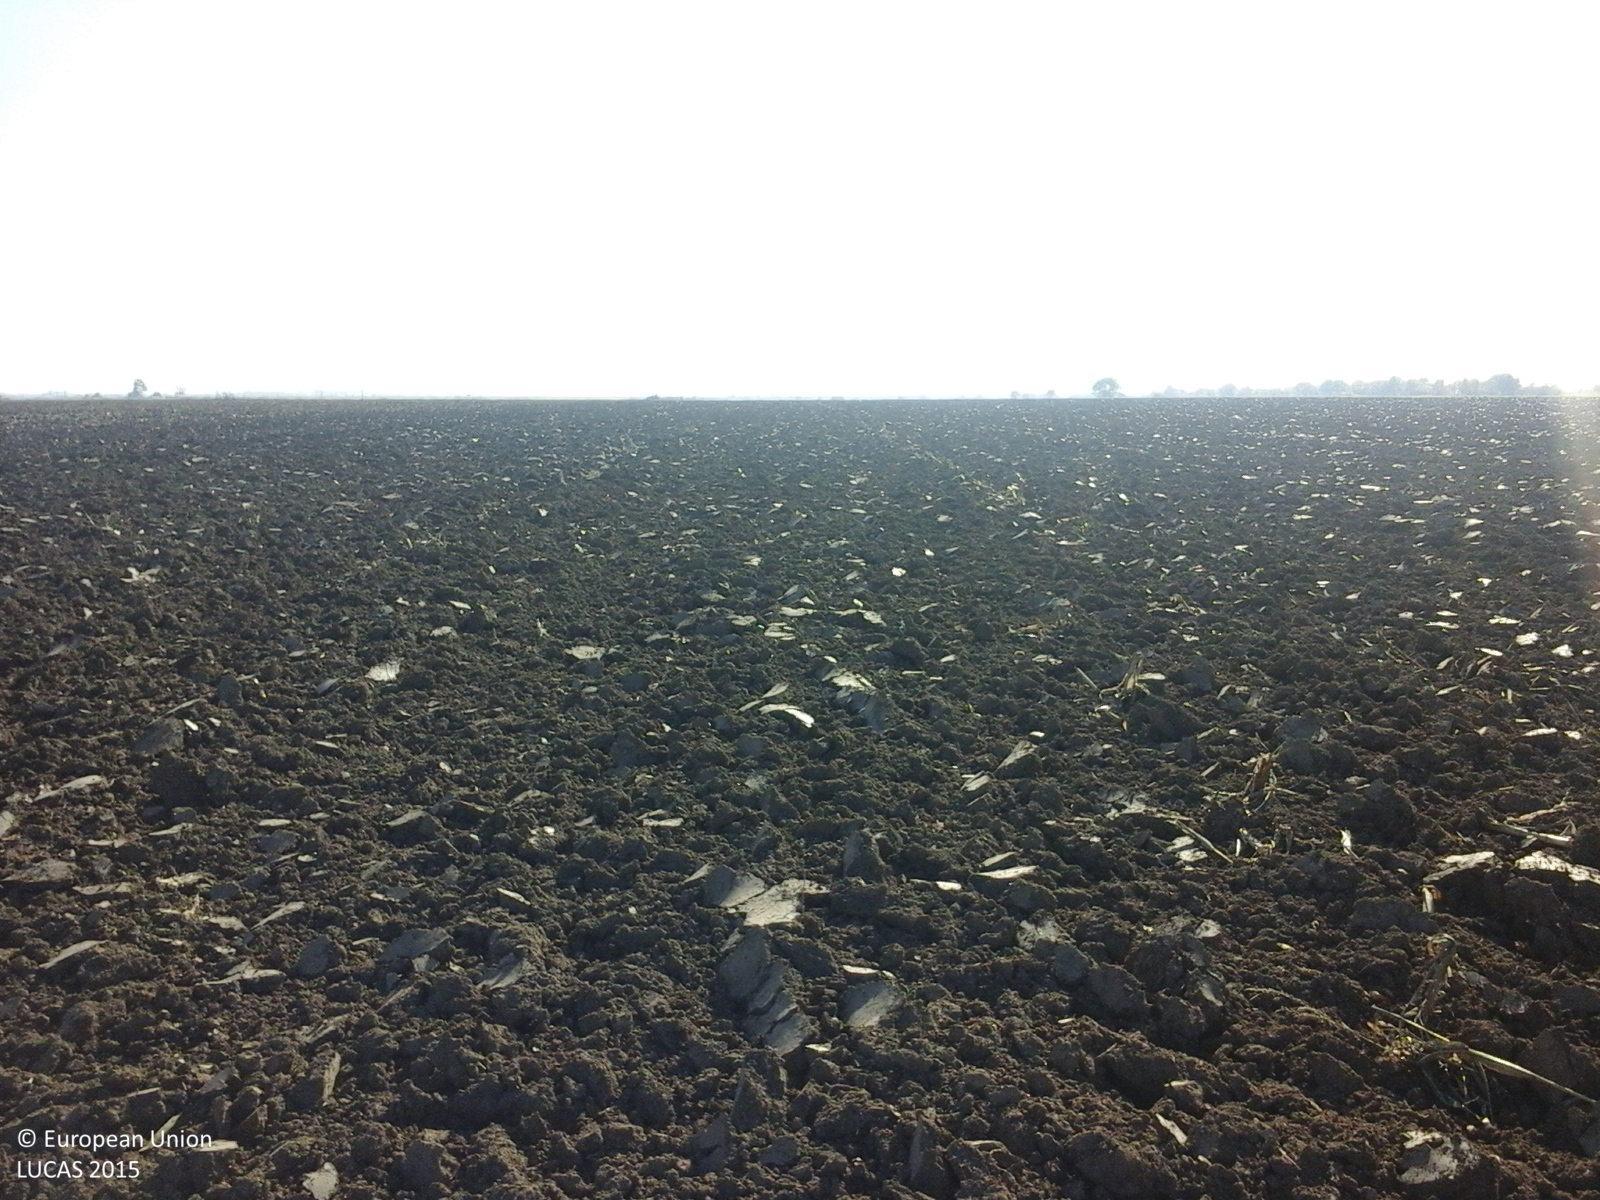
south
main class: Cropland
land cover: Maize
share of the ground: < 10 %
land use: Agriculture (excluding fallow land and kitchen gardens)
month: October
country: RO
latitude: 45.8835
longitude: 27.1957
